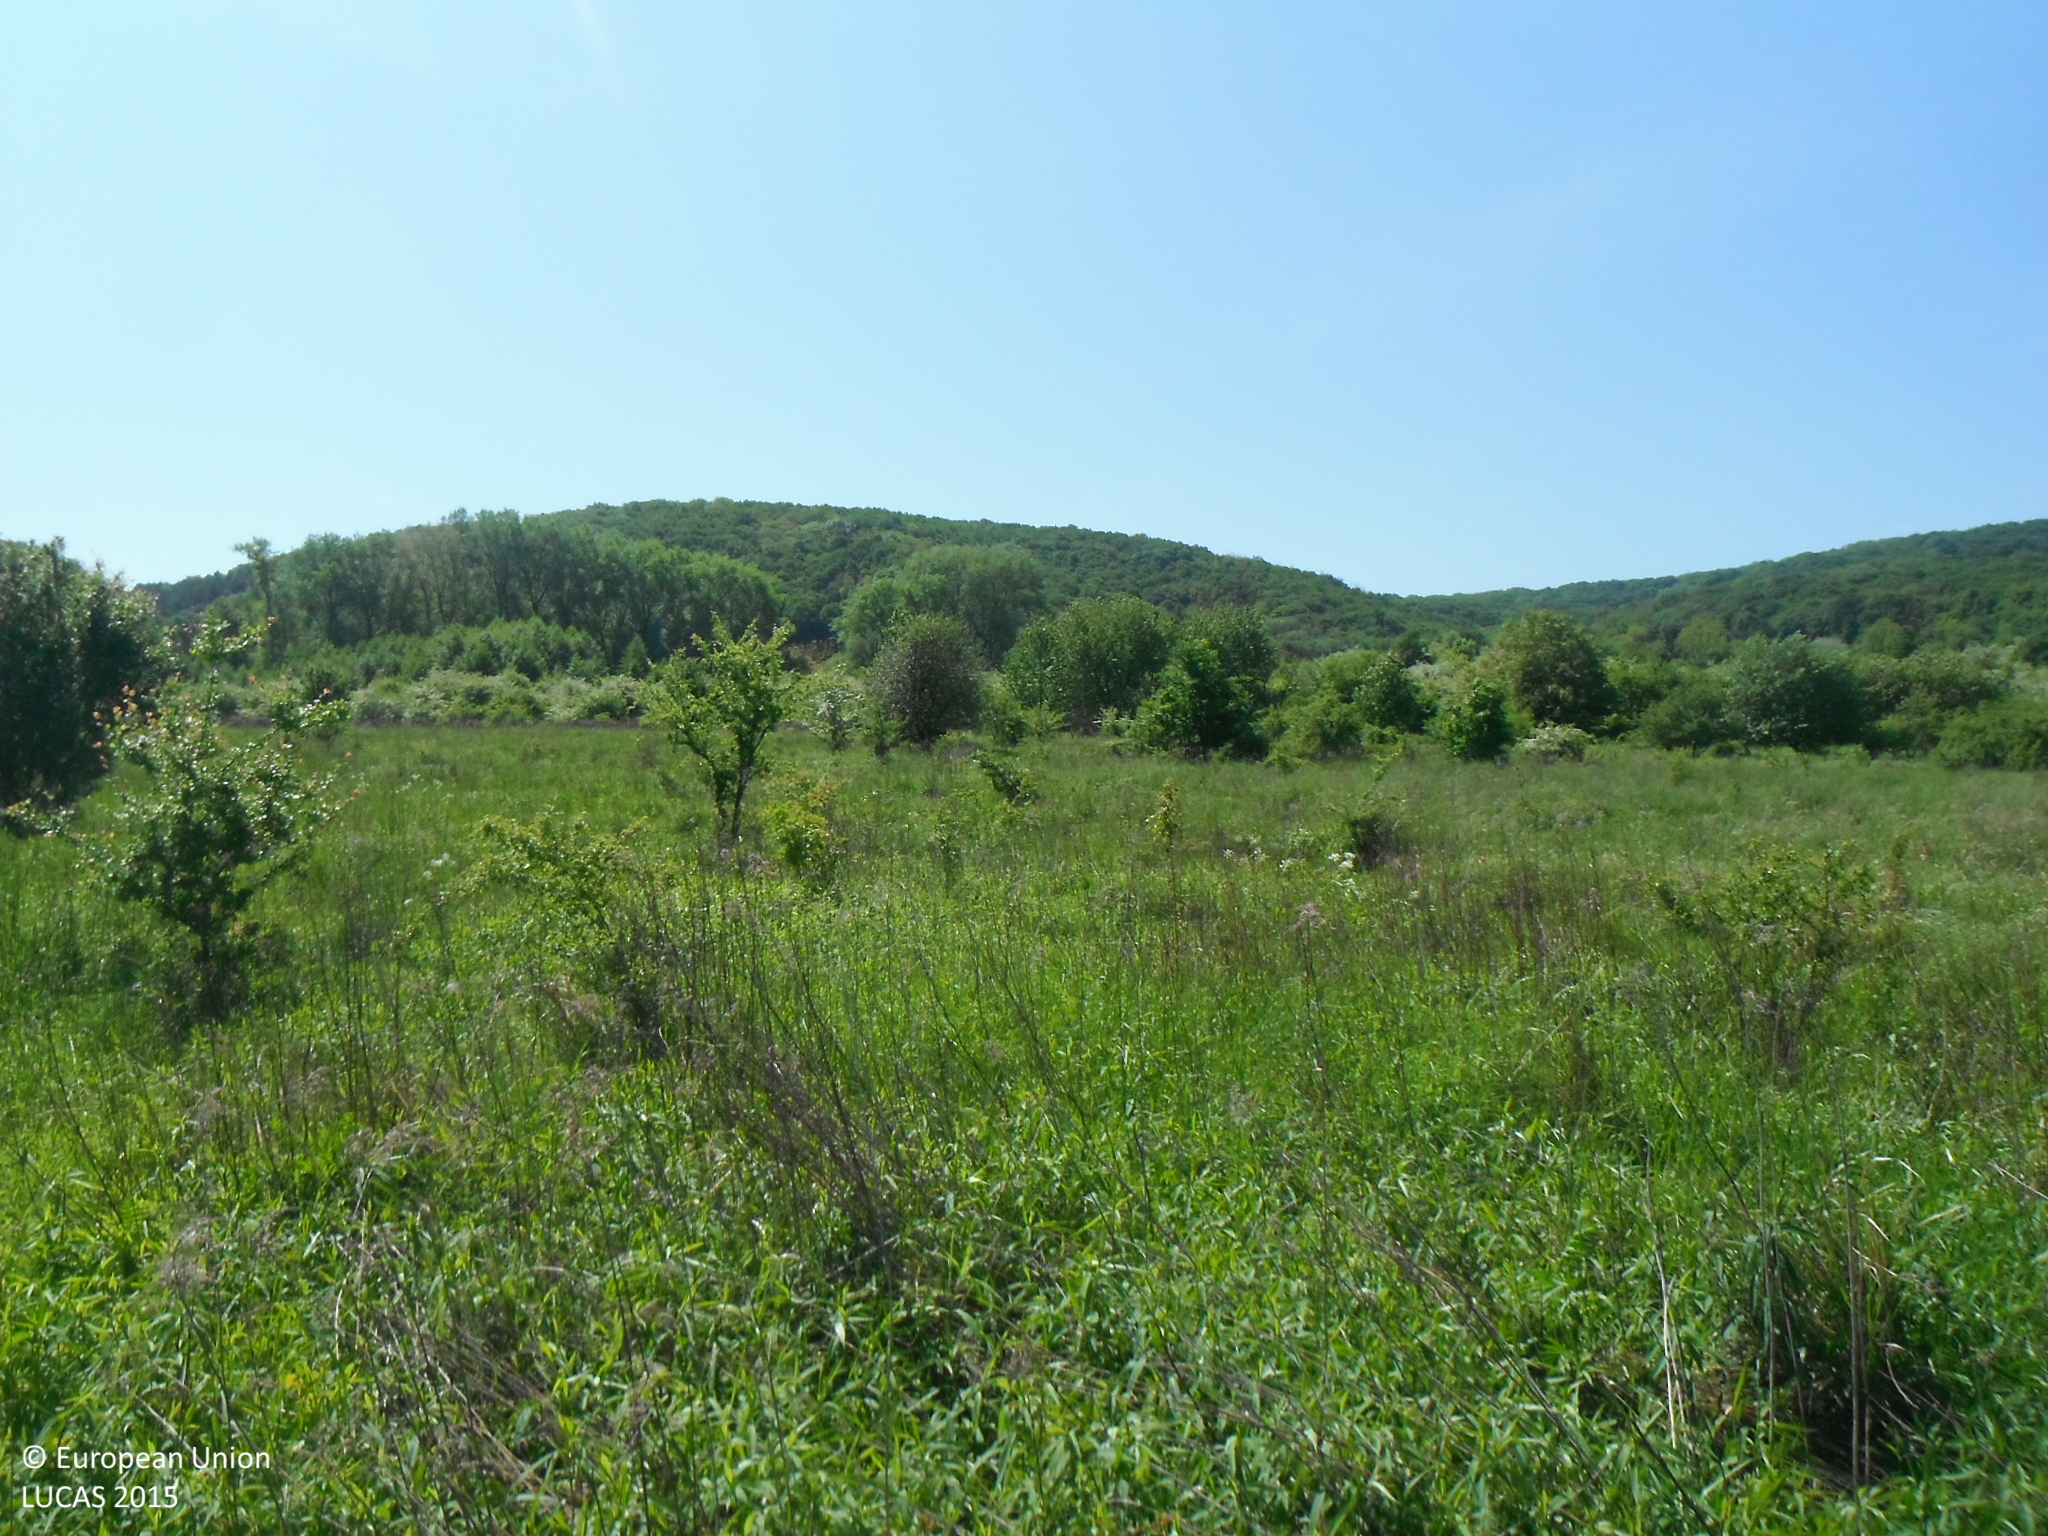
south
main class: Grassland
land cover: Grassland with sparse tree/shrub cover
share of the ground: > 75 %
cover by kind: herbaceous plants 90 %, broadleaved forest trees 5 %, shrubs 5 %
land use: Abandoned areas
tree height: < 5 m
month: May
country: SK
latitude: 48.1985
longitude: 17.0172
